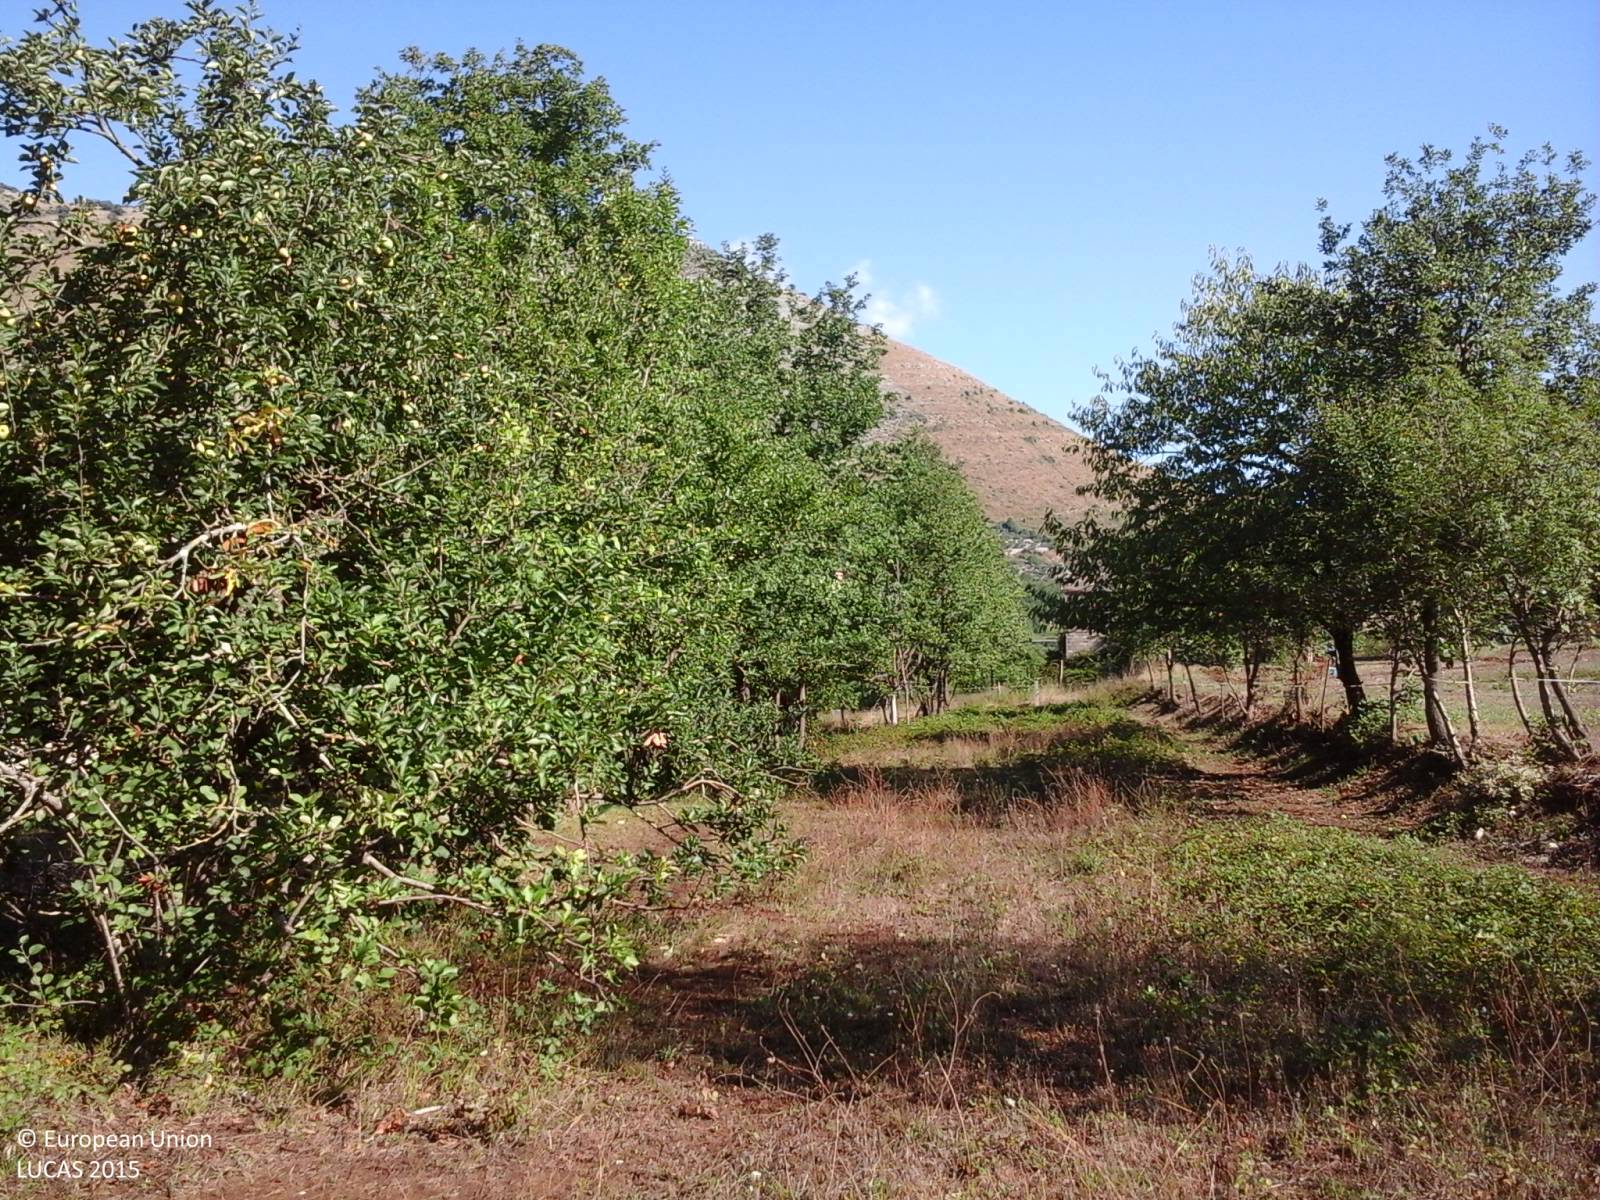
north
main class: Grassland
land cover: Grassland without tree/shrub cover
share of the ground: > 75 %
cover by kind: herbaceous plants 100 %
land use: Agriculture (excluding fallow land and kitchen gardens)
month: August
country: IT
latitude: 41.4216
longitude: 13.3967
